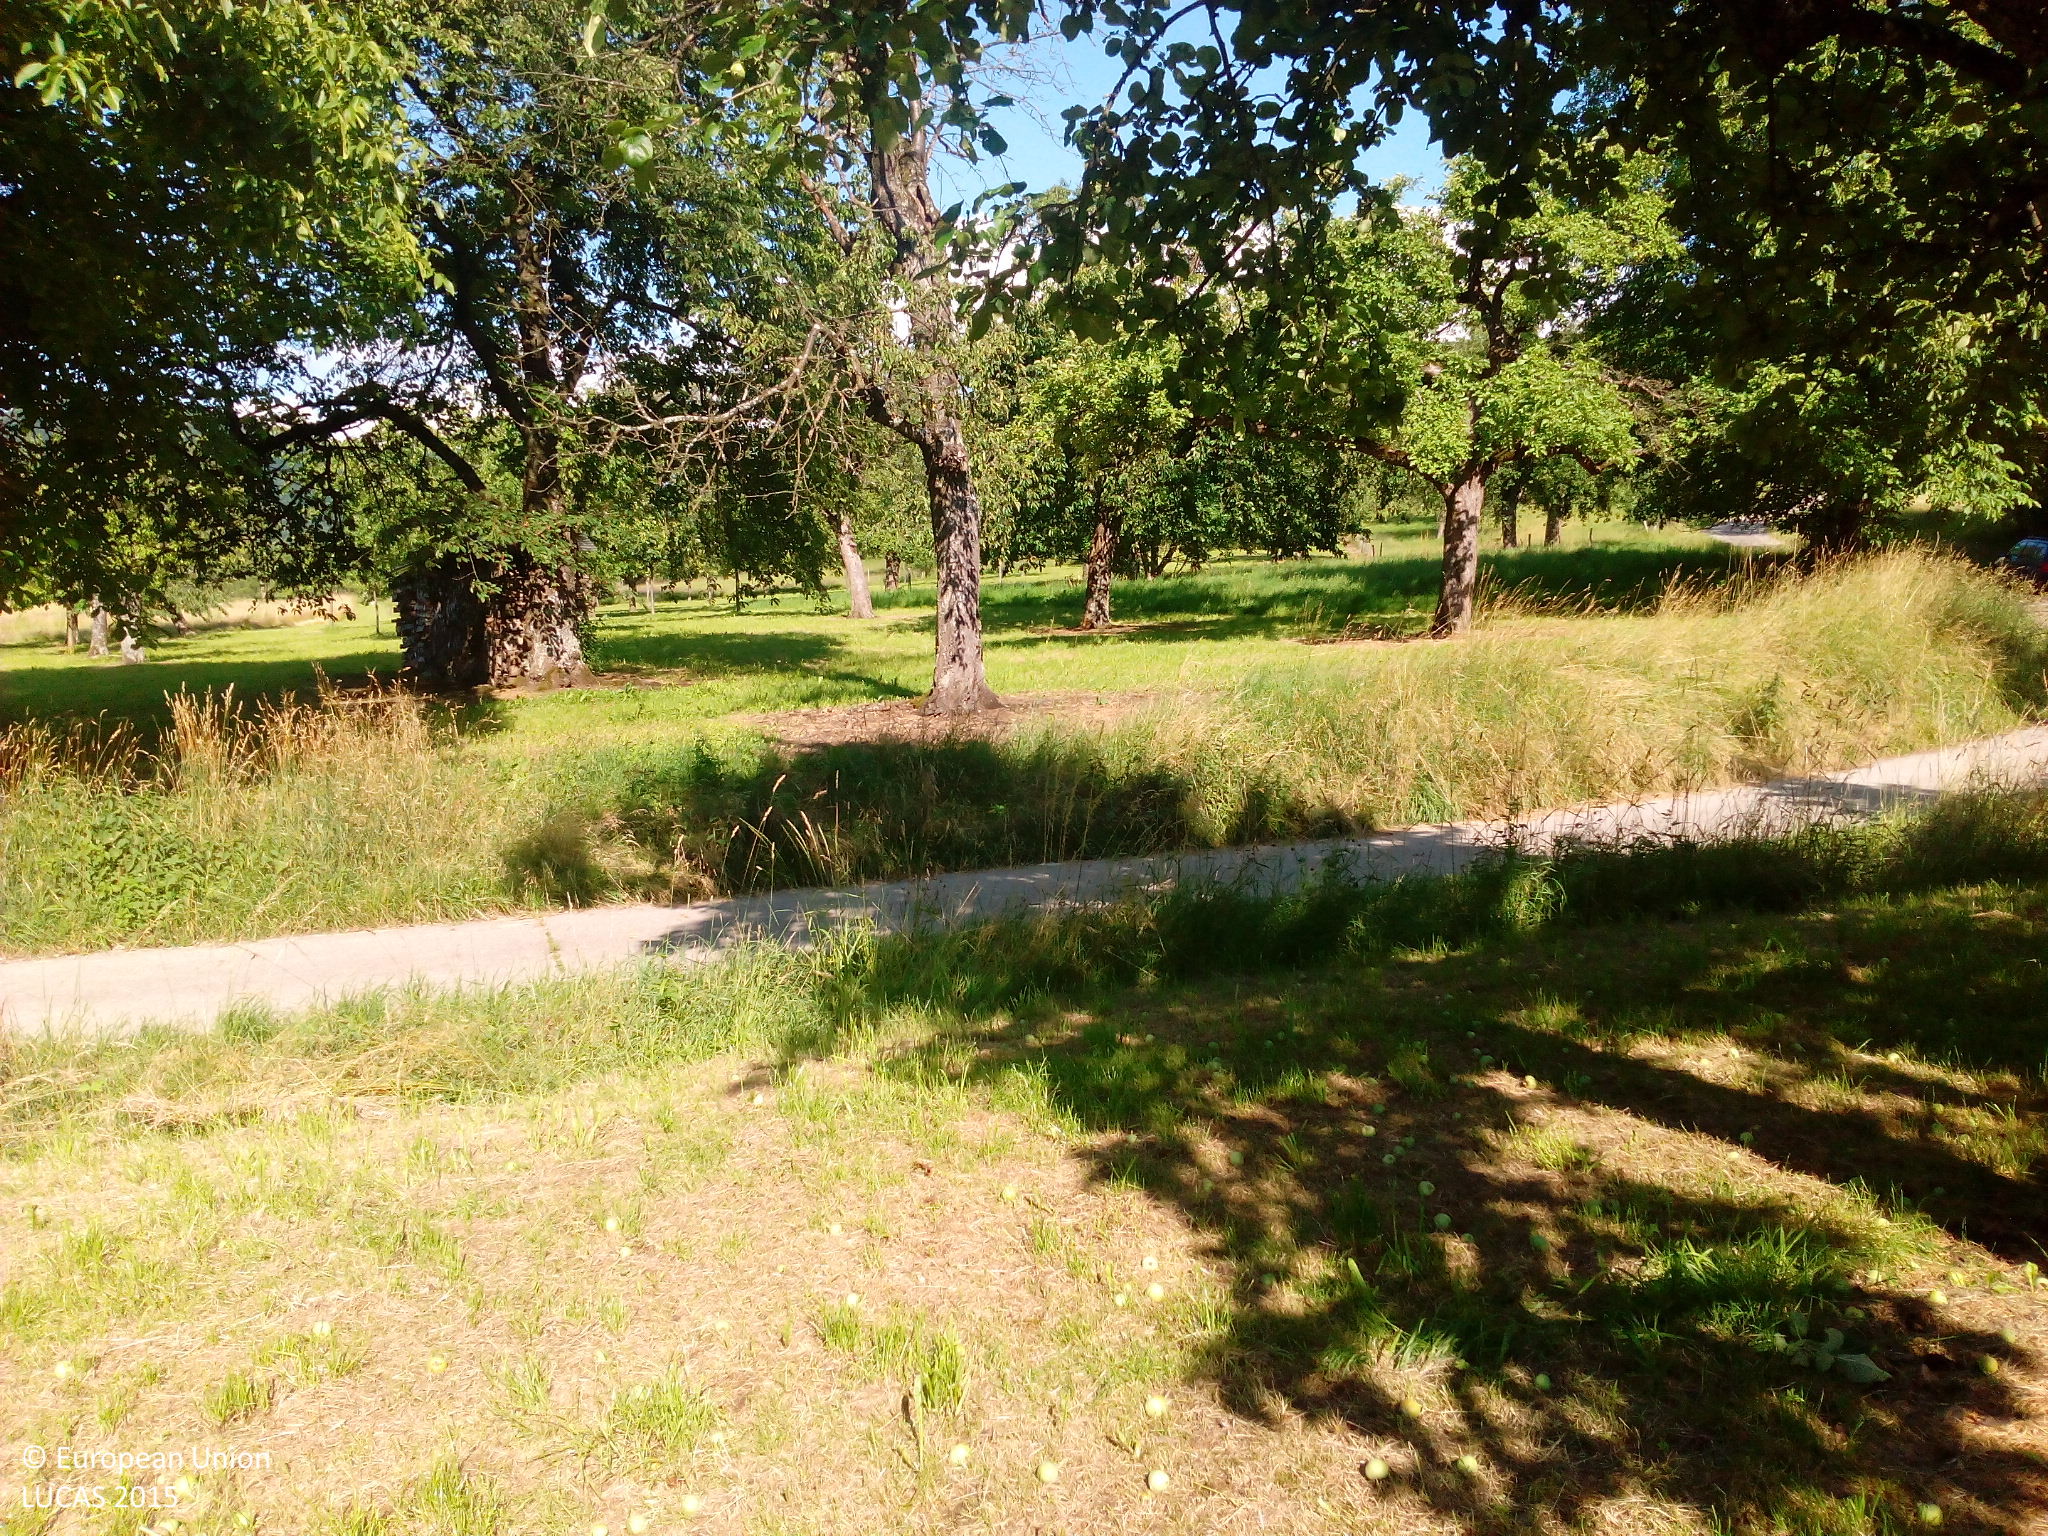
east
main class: Cropland
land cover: Apple fruit
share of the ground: 25 - 50 %
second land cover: Grassland without tree/shrub cover
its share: 50 - 75 %
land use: Agriculture (excluding fallow land and kitchen gardens)
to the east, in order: Apple fruit; Grassland without tree/shrub cover; Ditches and canals; Grass margins; Paved roads, cycling and walking lanes; Cherry fruit; Nuts trees; Cherry fruit; Fences; Apple fruit; Grassland without tree/shrub cover; Apple fruit; Fences; Other fruit trees and berries
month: June
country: DE
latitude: 48.5637
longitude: 9.3905
